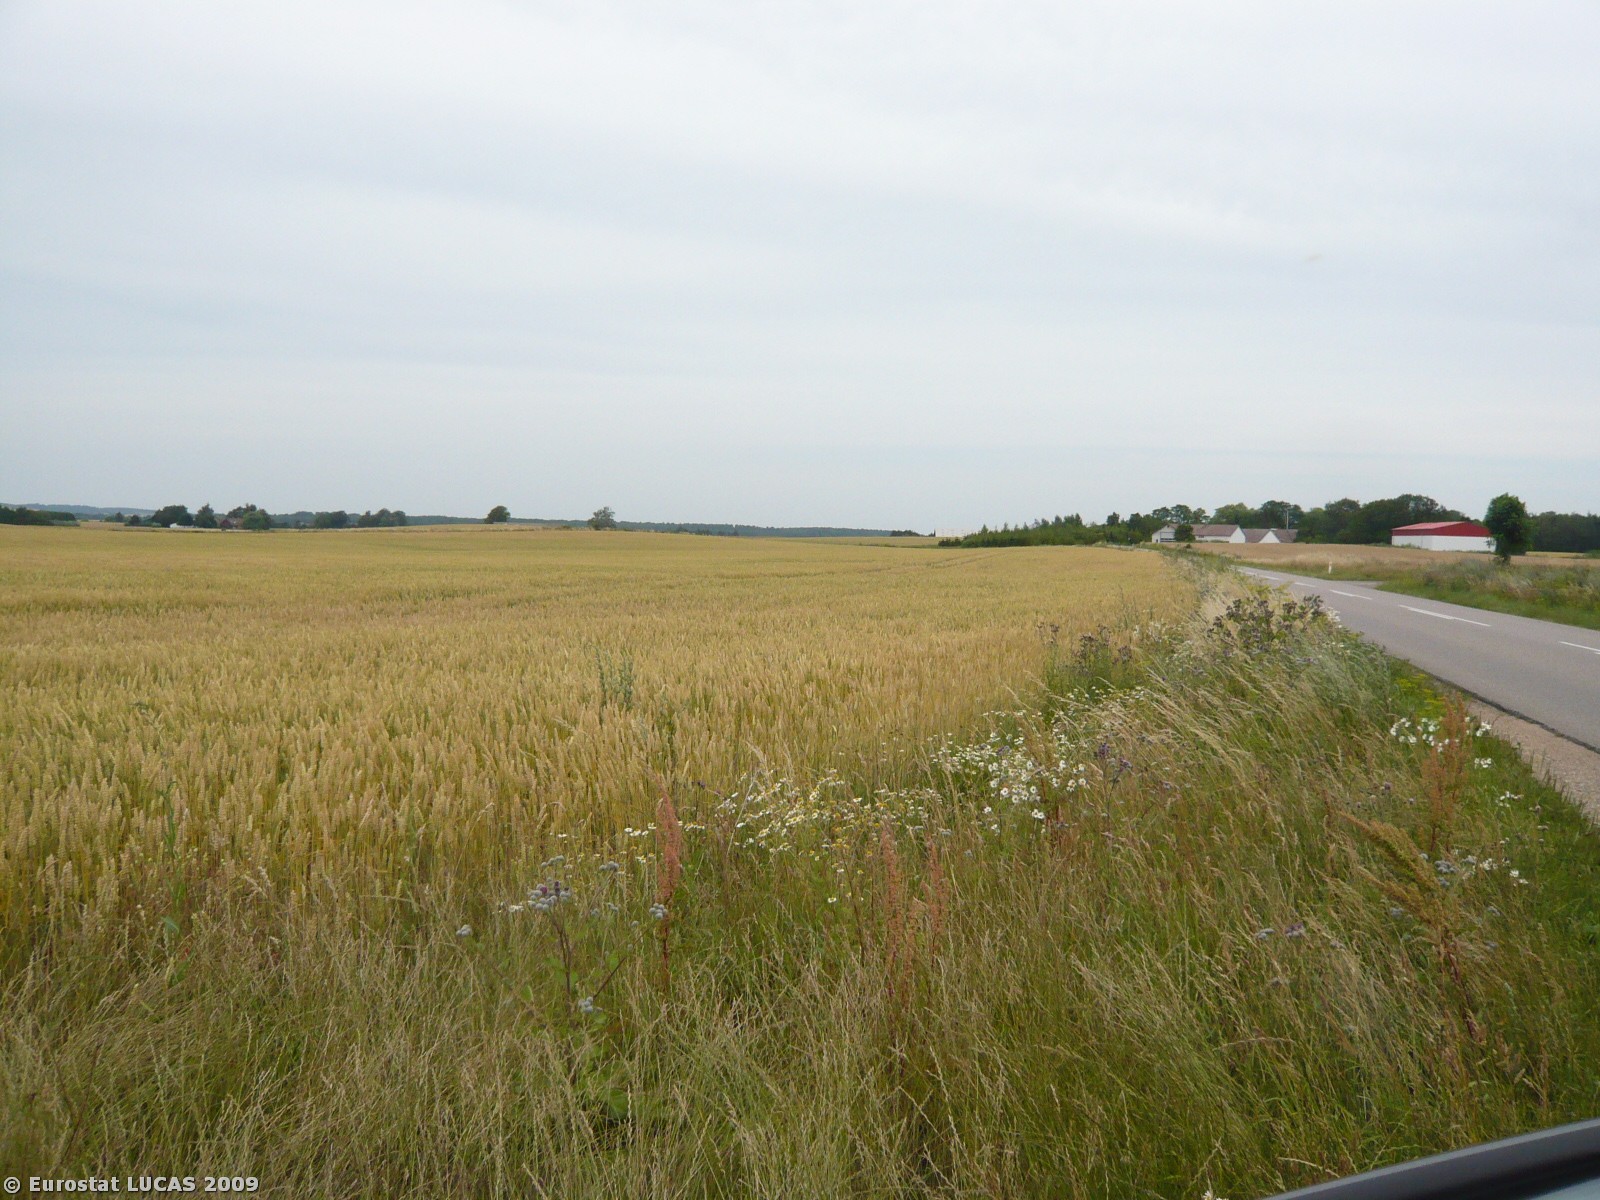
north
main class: Cropland
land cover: Common wheat
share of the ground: > 75 %
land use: Agriculture (excluding fallow land and kitchen gardens)
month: July
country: DK
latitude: 55.5648
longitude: 11.7269
